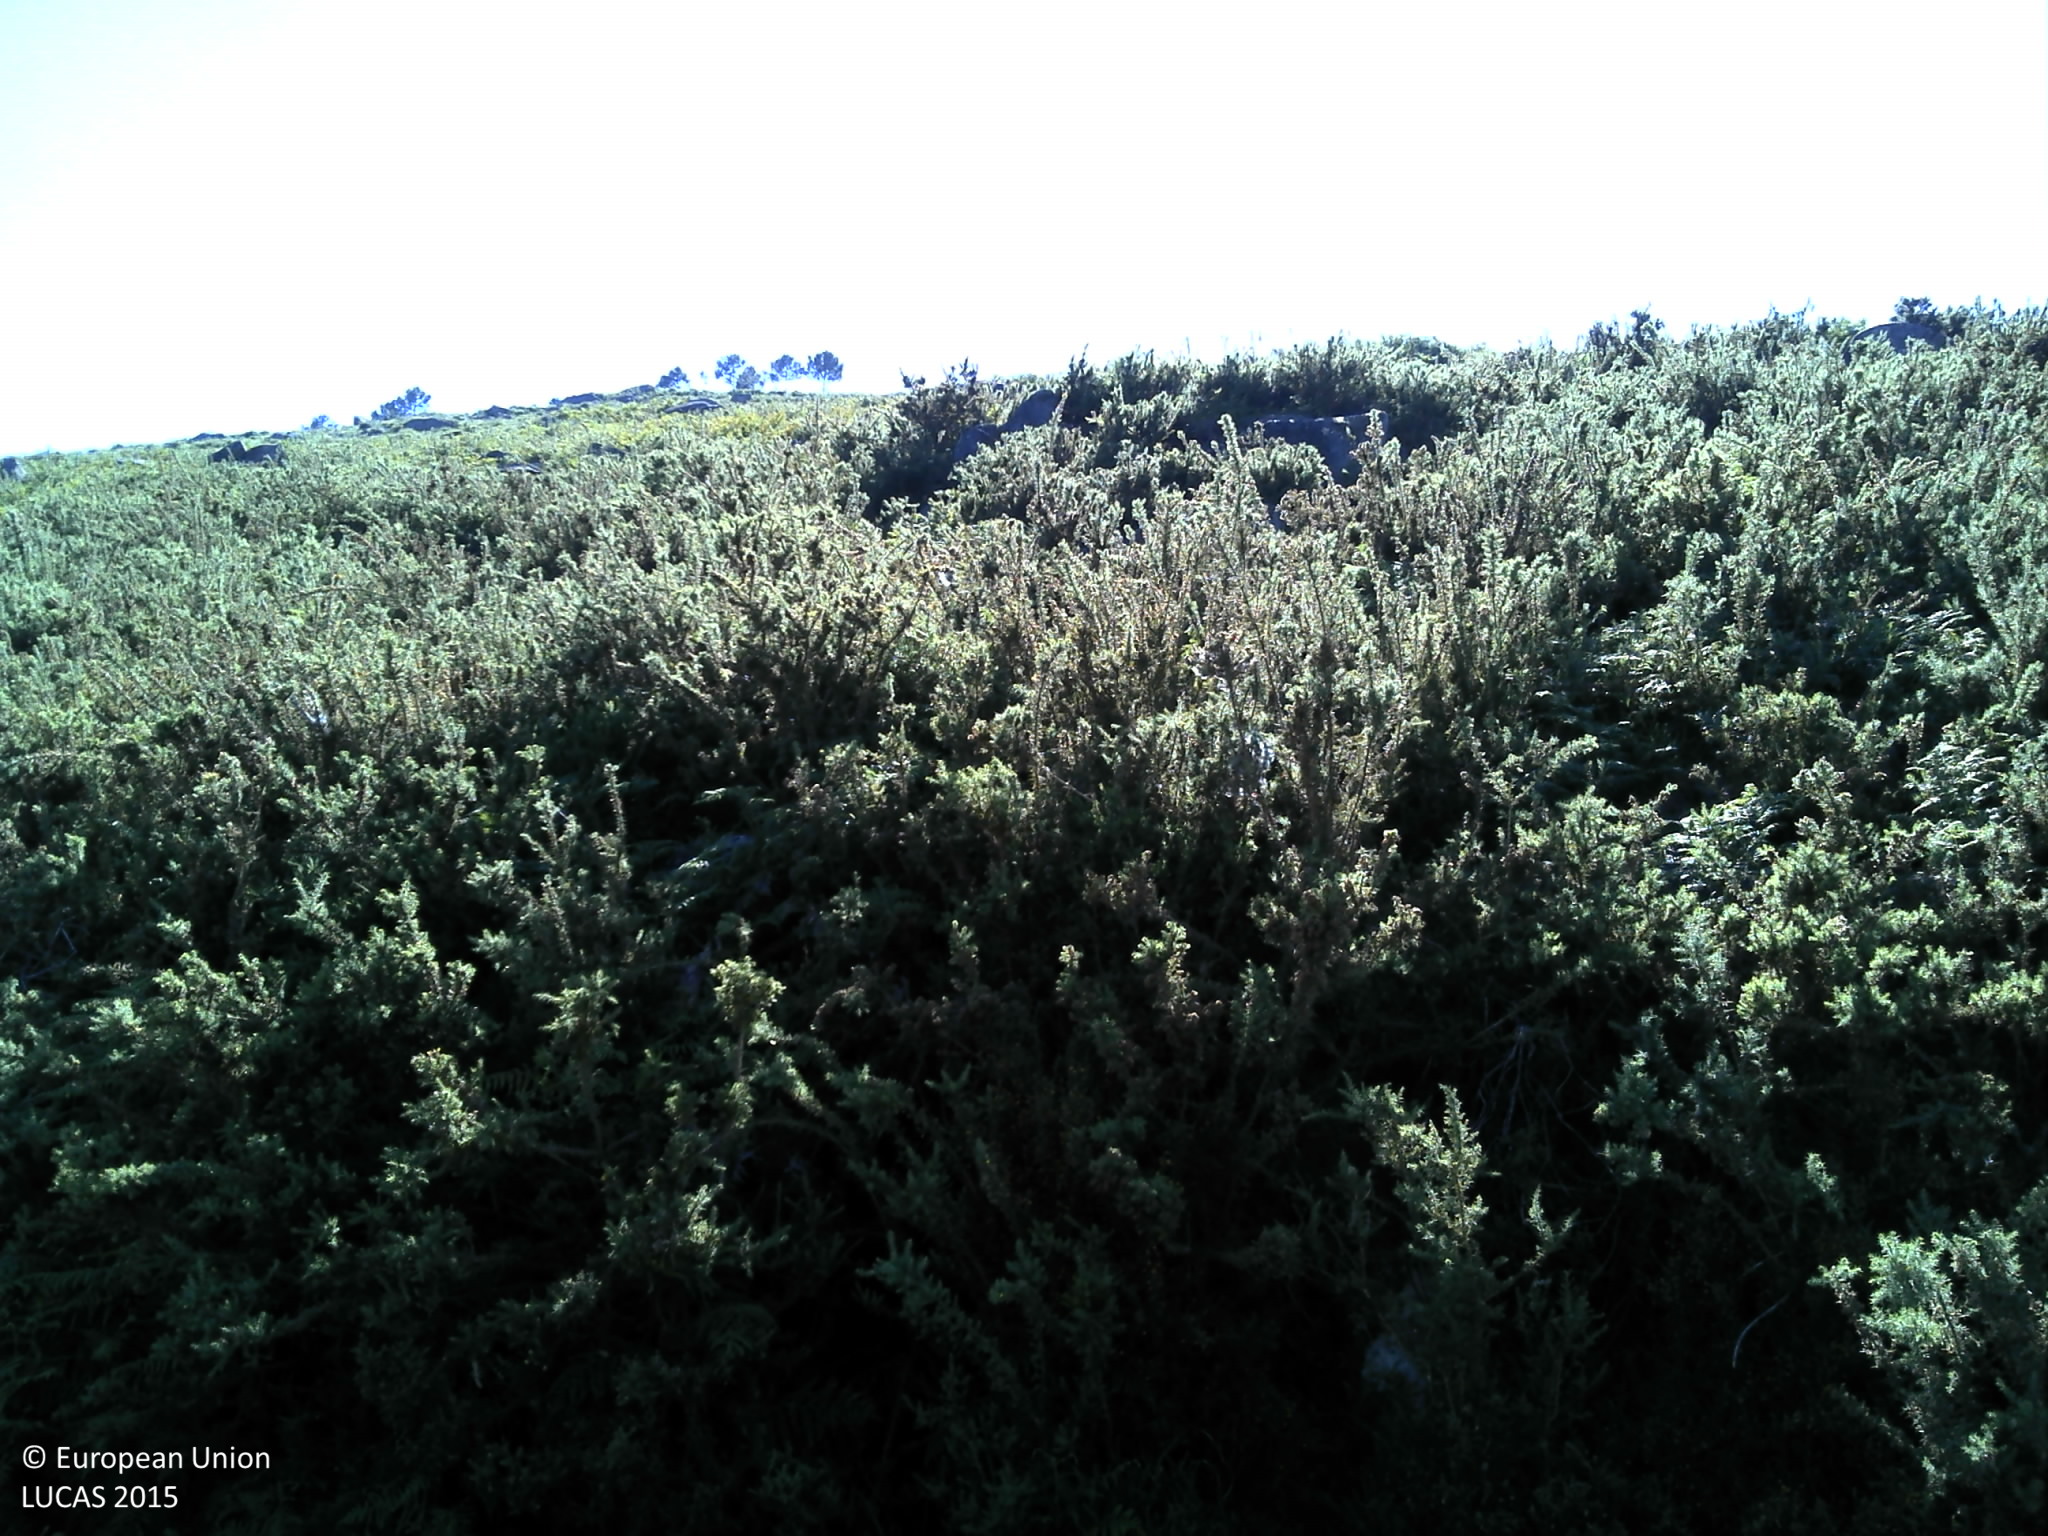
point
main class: Shrubland
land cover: Shrubland without tree cover
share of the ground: > 75 %
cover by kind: shrubs 80 %, herbaceous plants 15 %, unconsolidated bare surface 5 %
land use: Semi-natural and natural areas not in use
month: May
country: PT
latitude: 41.7281
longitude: -8.5911
